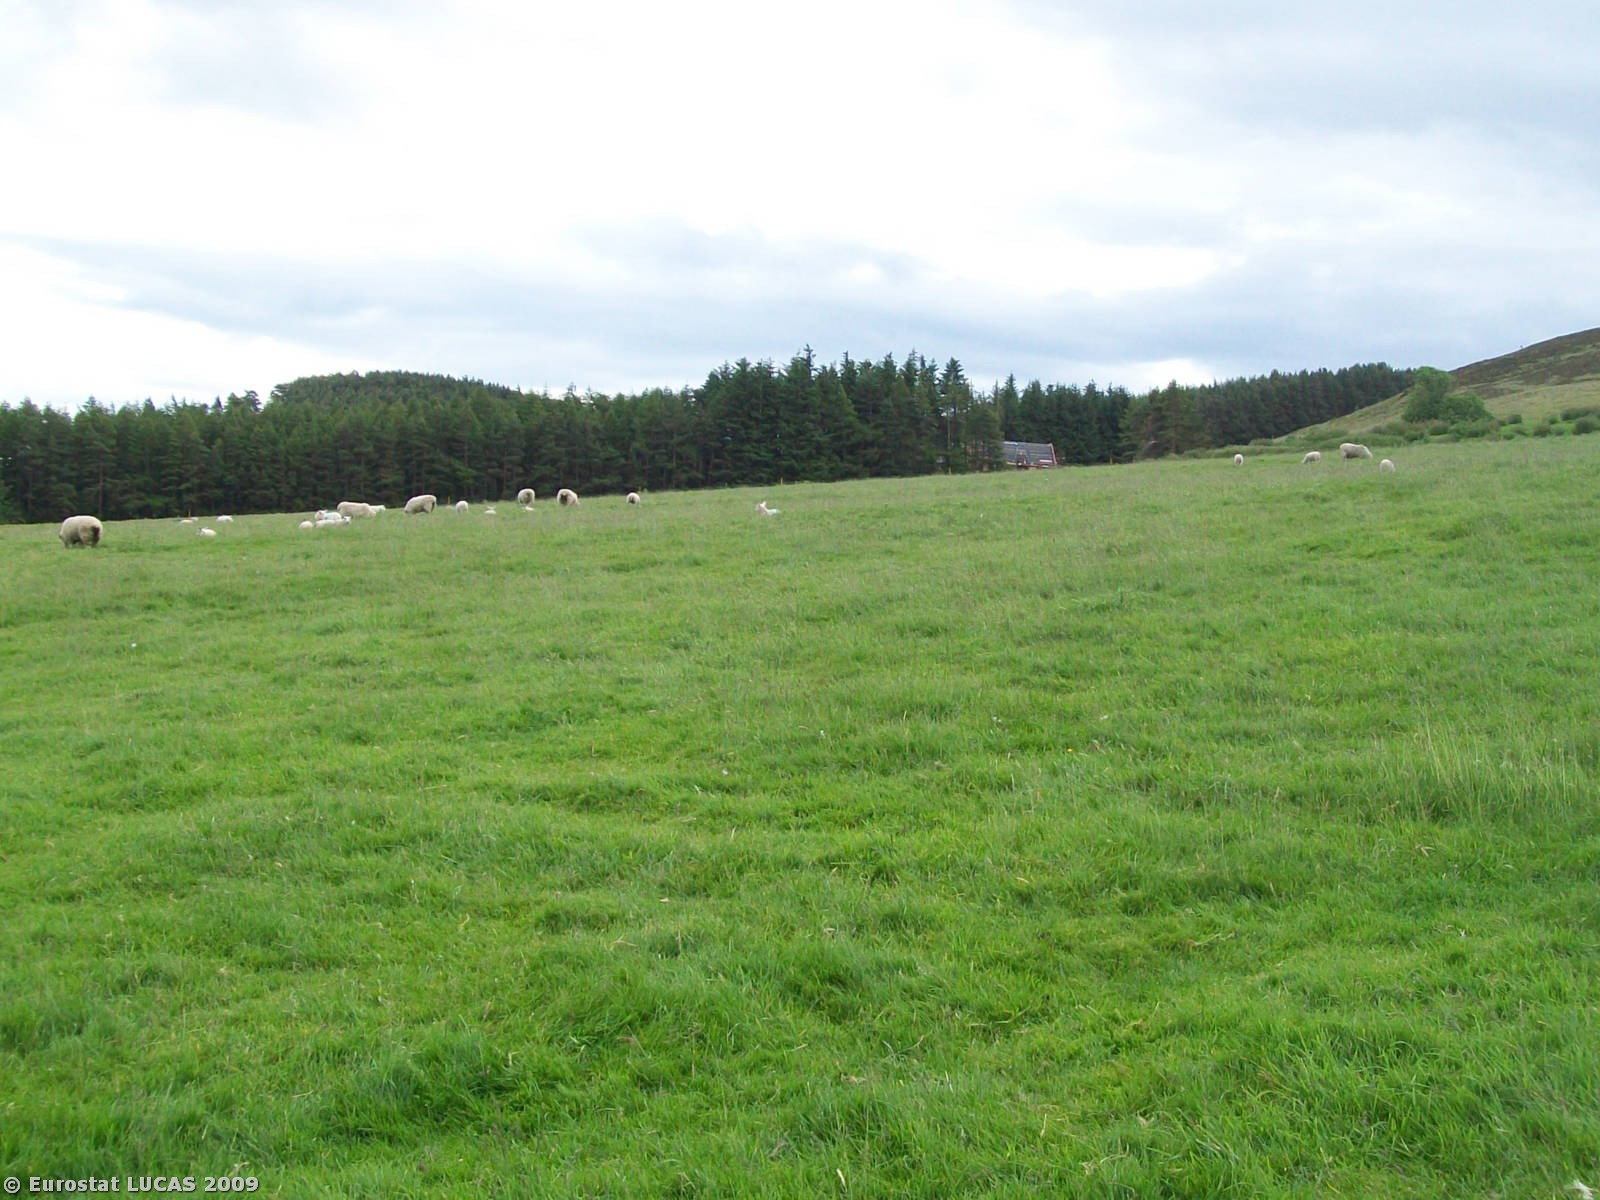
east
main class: Grassland
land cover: Grassland without tree/shrub cover
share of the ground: > 75 %
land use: Agriculture (excluding fallow land and kitchen gardens)
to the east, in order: Grassland without tree/shrub cover; Fences; Grassland without tree/shrub cover
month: June
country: GB
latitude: 56.2711
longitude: -3.6927
